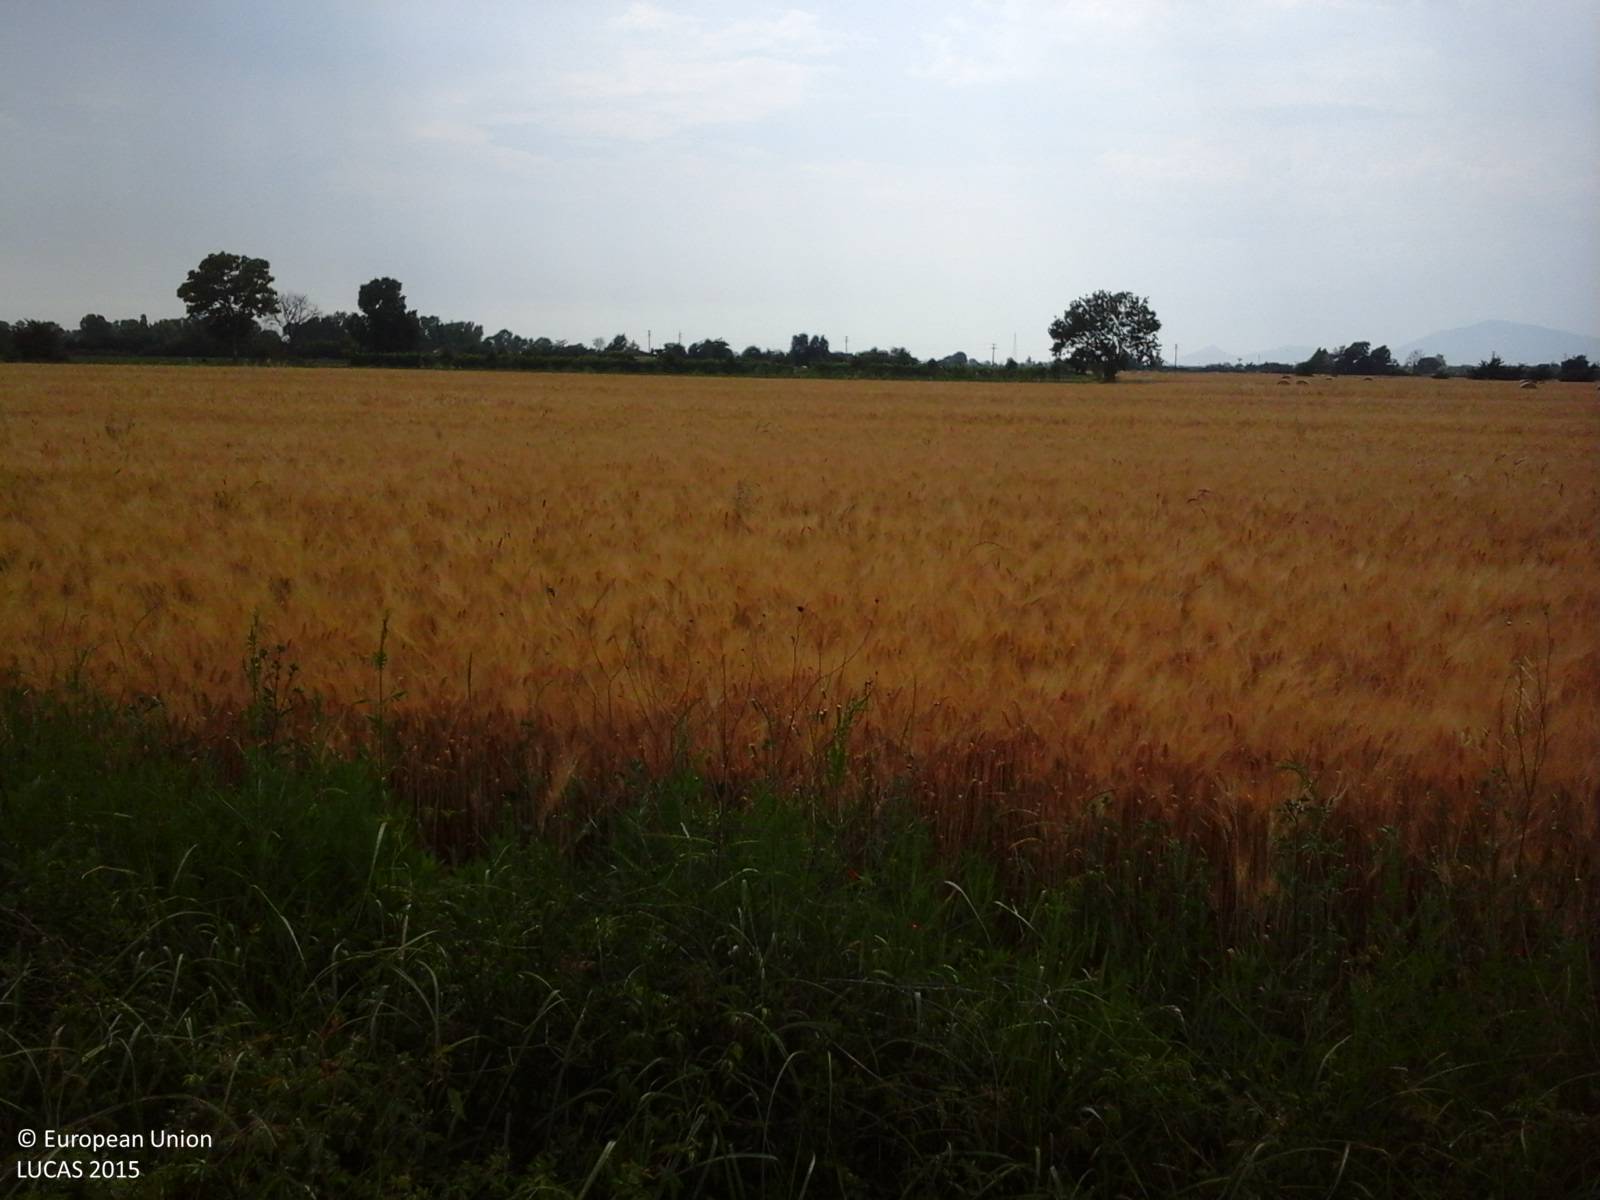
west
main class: Cropland
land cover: Barley
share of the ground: > 75 %
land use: Agriculture (excluding fallow land and kitchen gardens)
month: June
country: IT
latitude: 41.0838
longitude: 14.1852
